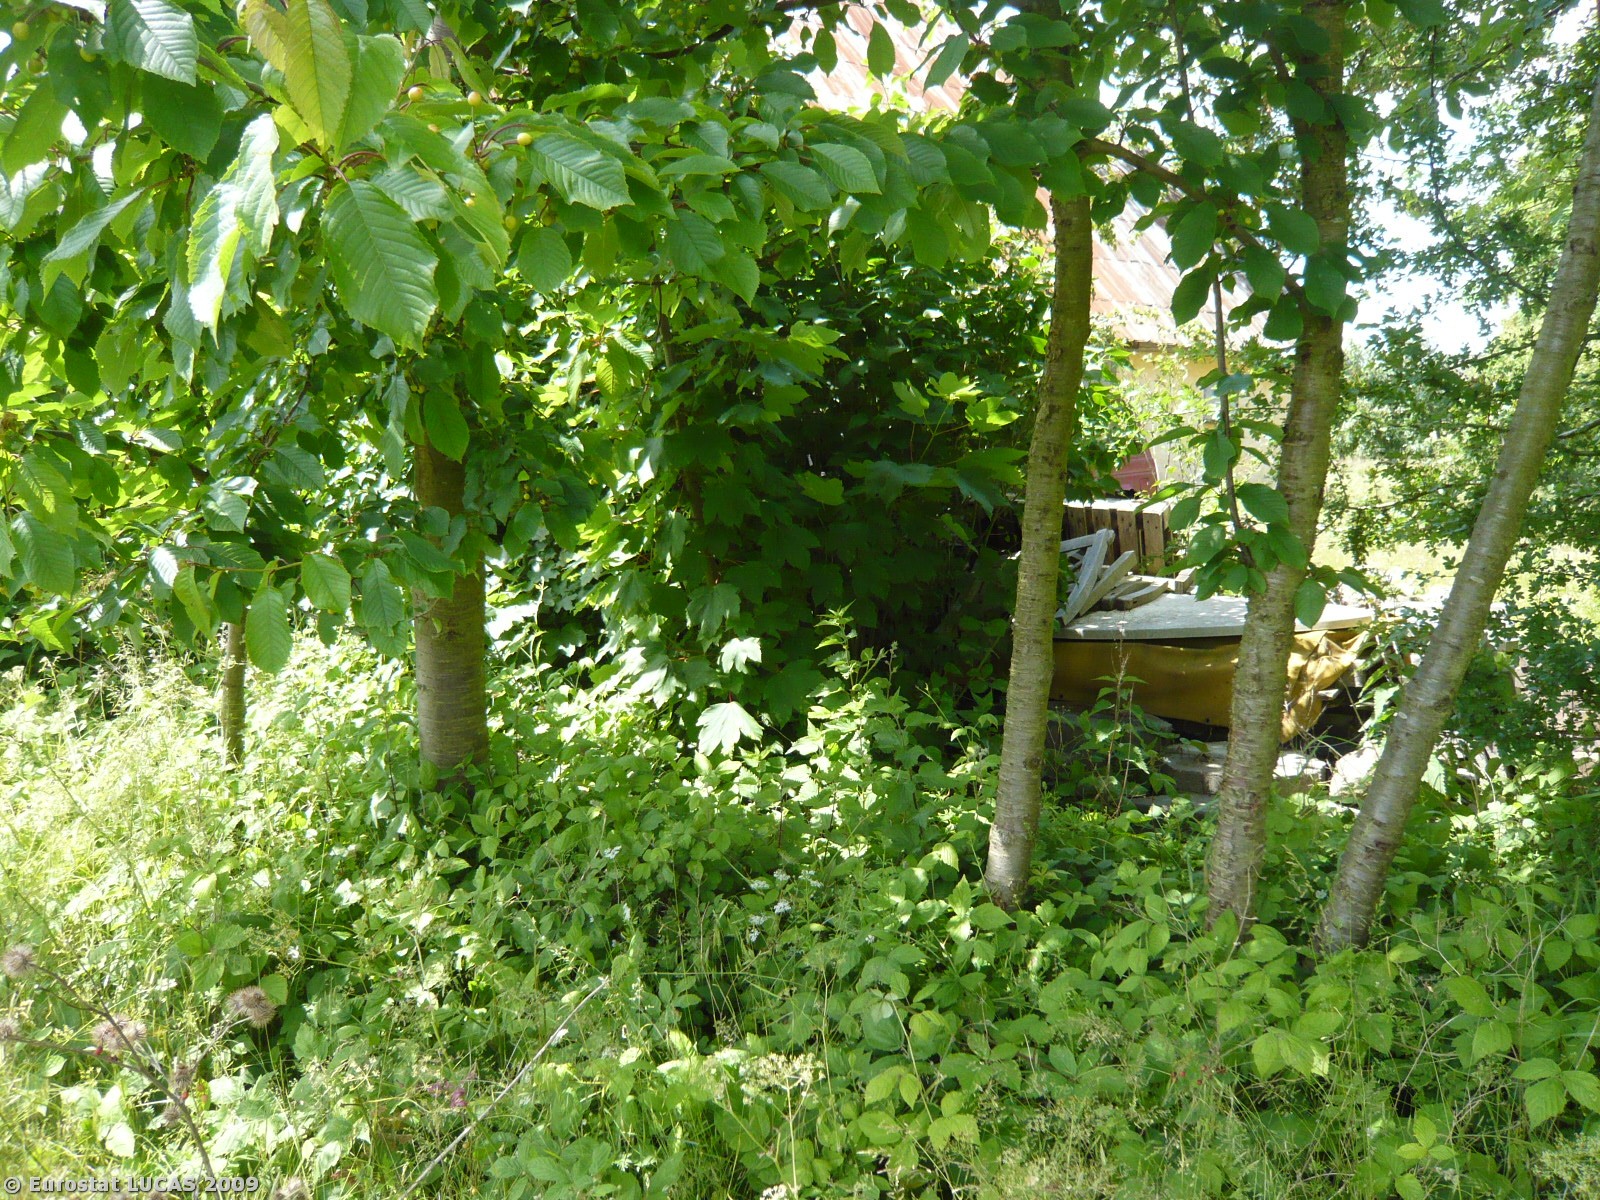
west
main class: Cropland
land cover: Barley
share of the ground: > 75 %
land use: Agriculture (excluding fallow land and kitchen gardens)
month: June
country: DK
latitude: 54.9408
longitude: 11.2947
